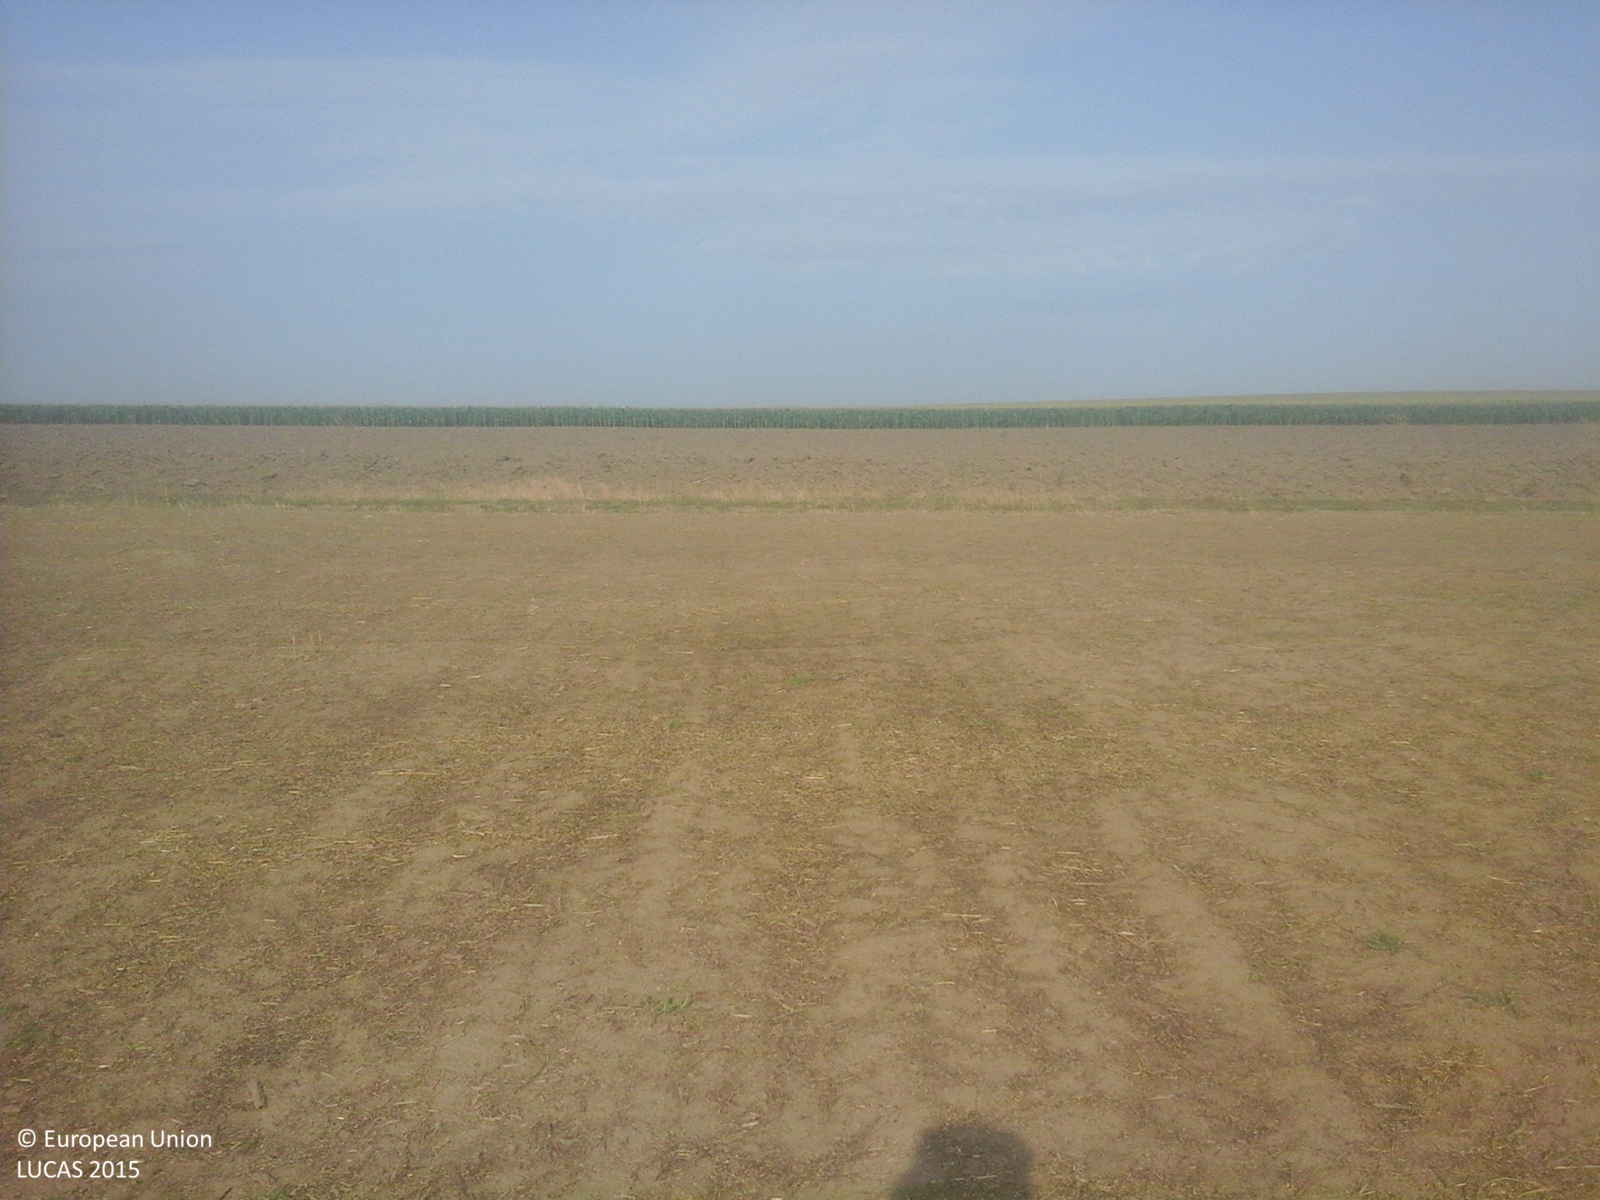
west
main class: Cropland
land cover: Common wheat
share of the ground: < 10 %
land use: Agriculture (excluding fallow land and kitchen gardens)
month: August
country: RO
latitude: 43.9928
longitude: 28.2269
